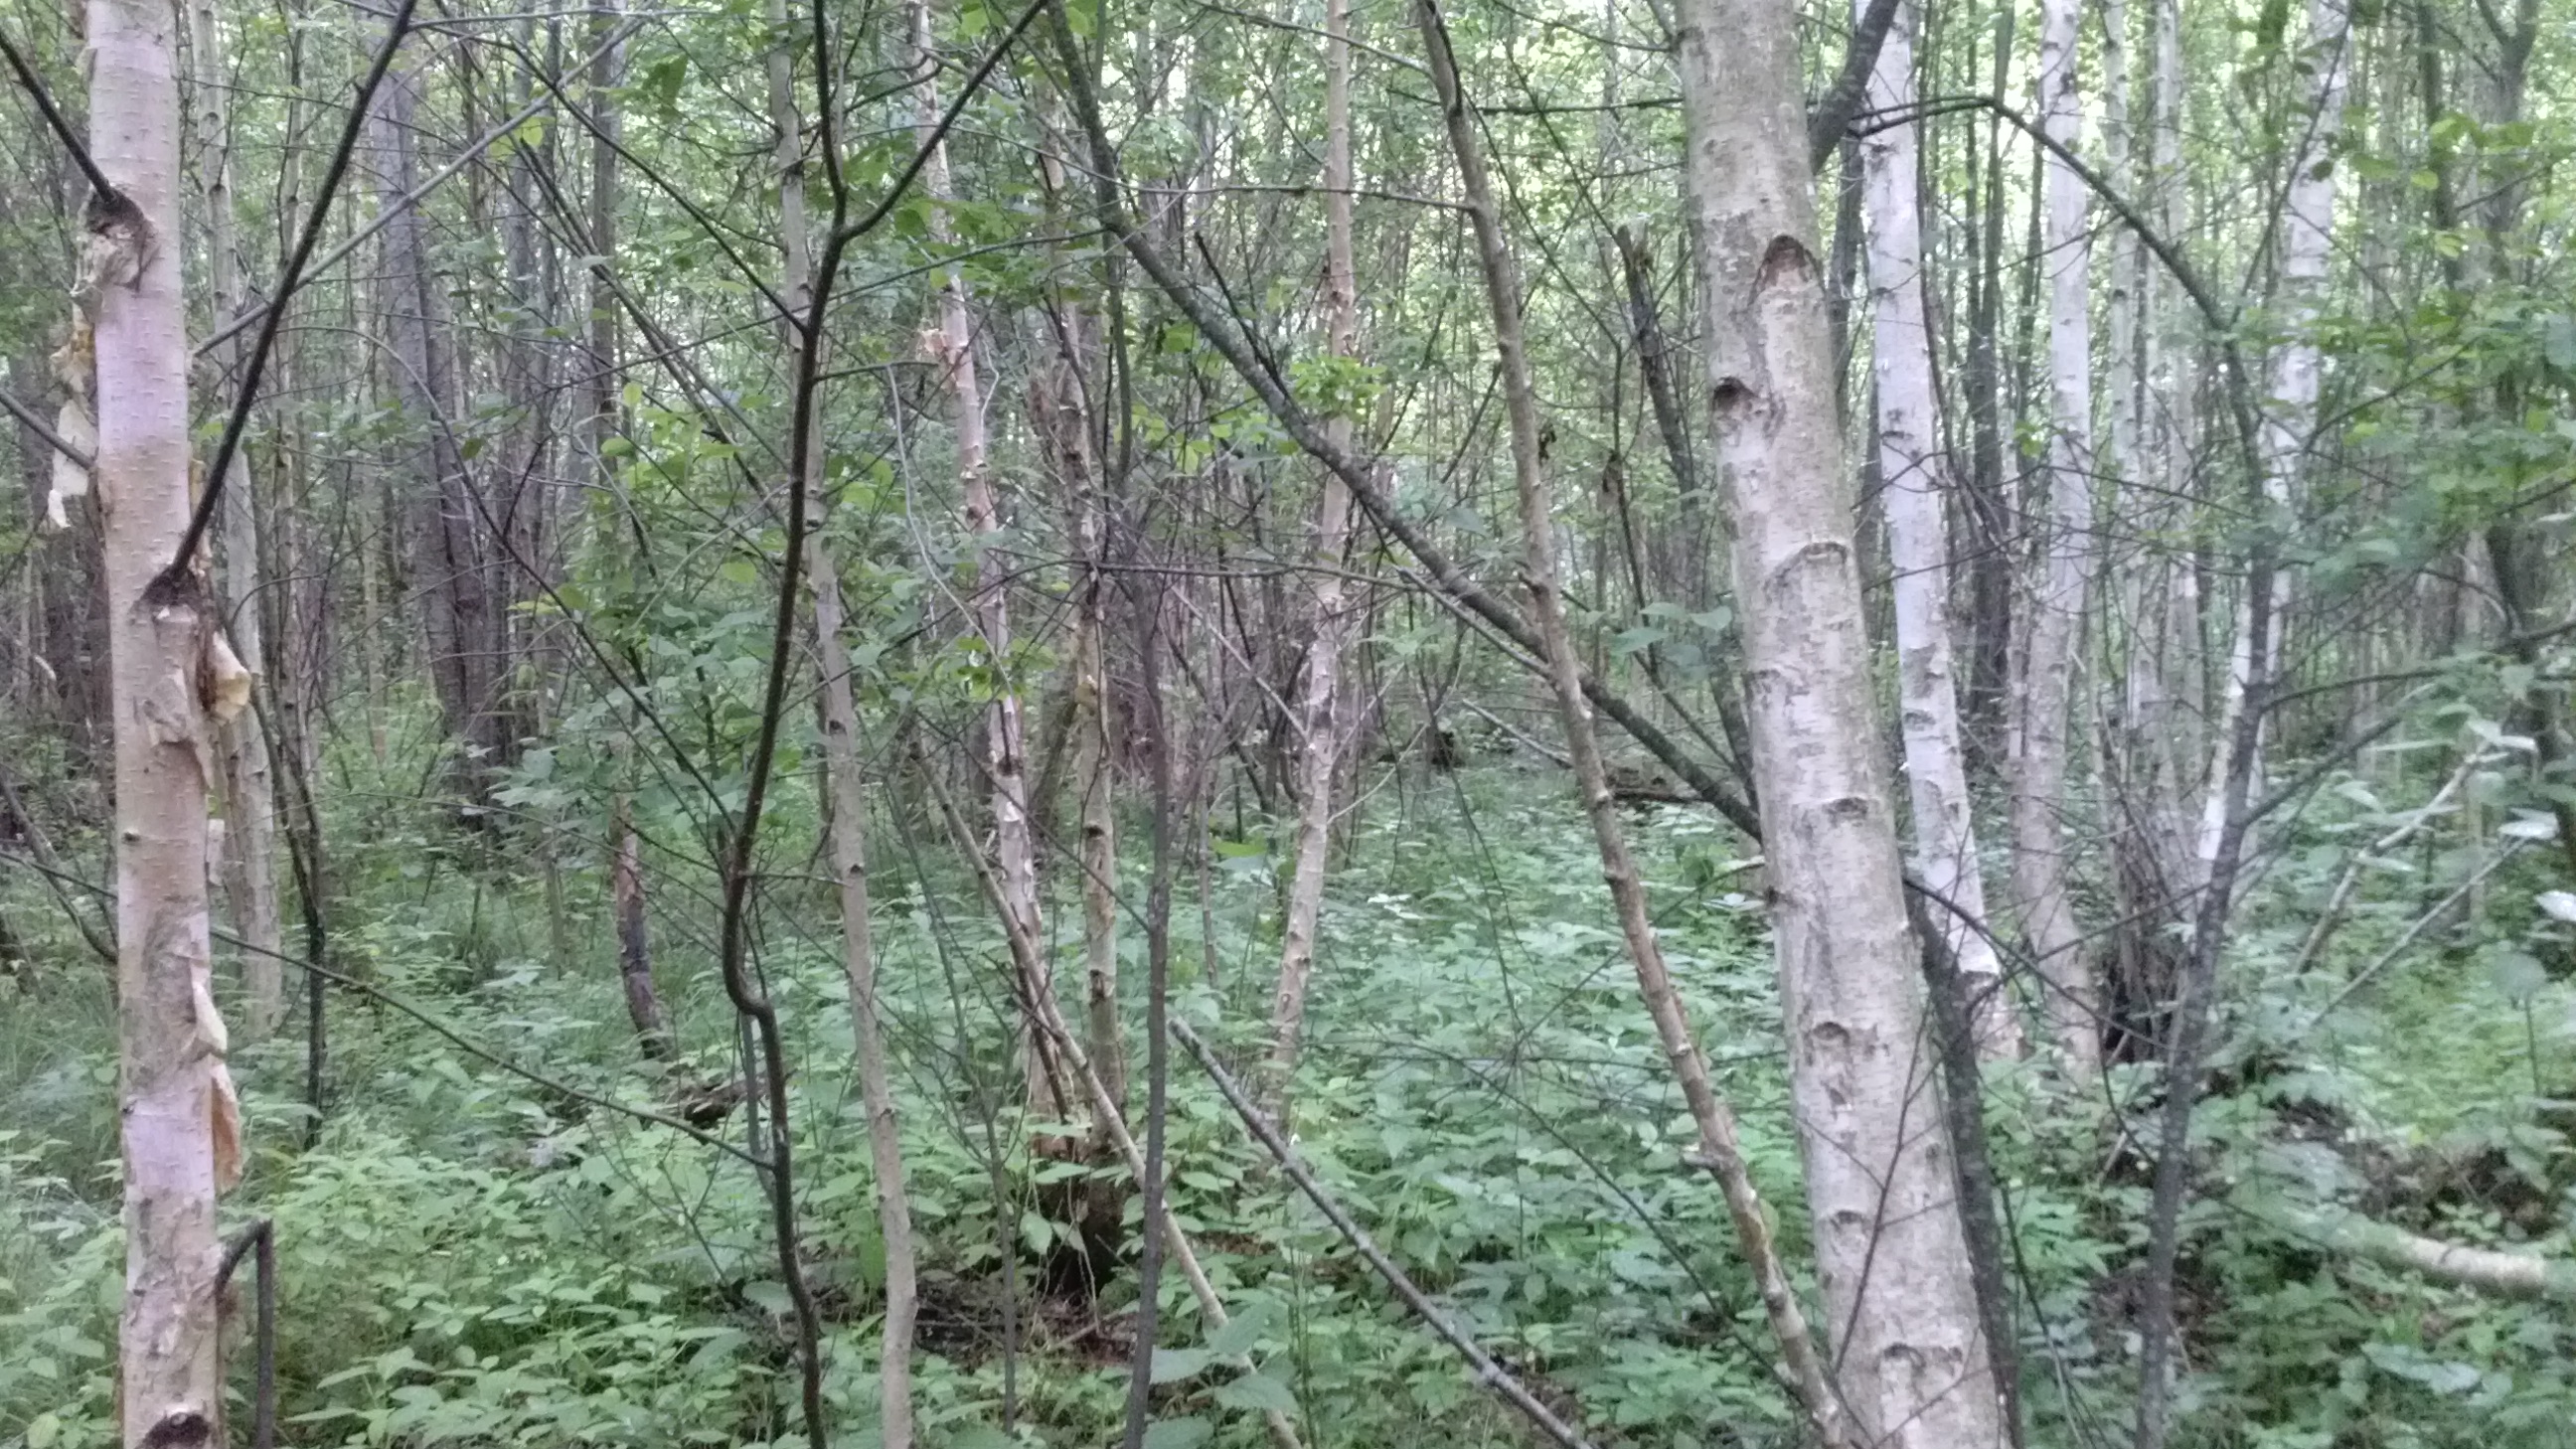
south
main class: Woodland
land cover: Broadleaved woodland
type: non-riverine alder, birch or aspen forest
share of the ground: > 75 %
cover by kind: broadleaved forest trees 80 %, herbaceous plants 15 %, shrubs 5 %
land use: Forestry
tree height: > 5 m
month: June
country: LV
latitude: 56.6082
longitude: 27.9354
